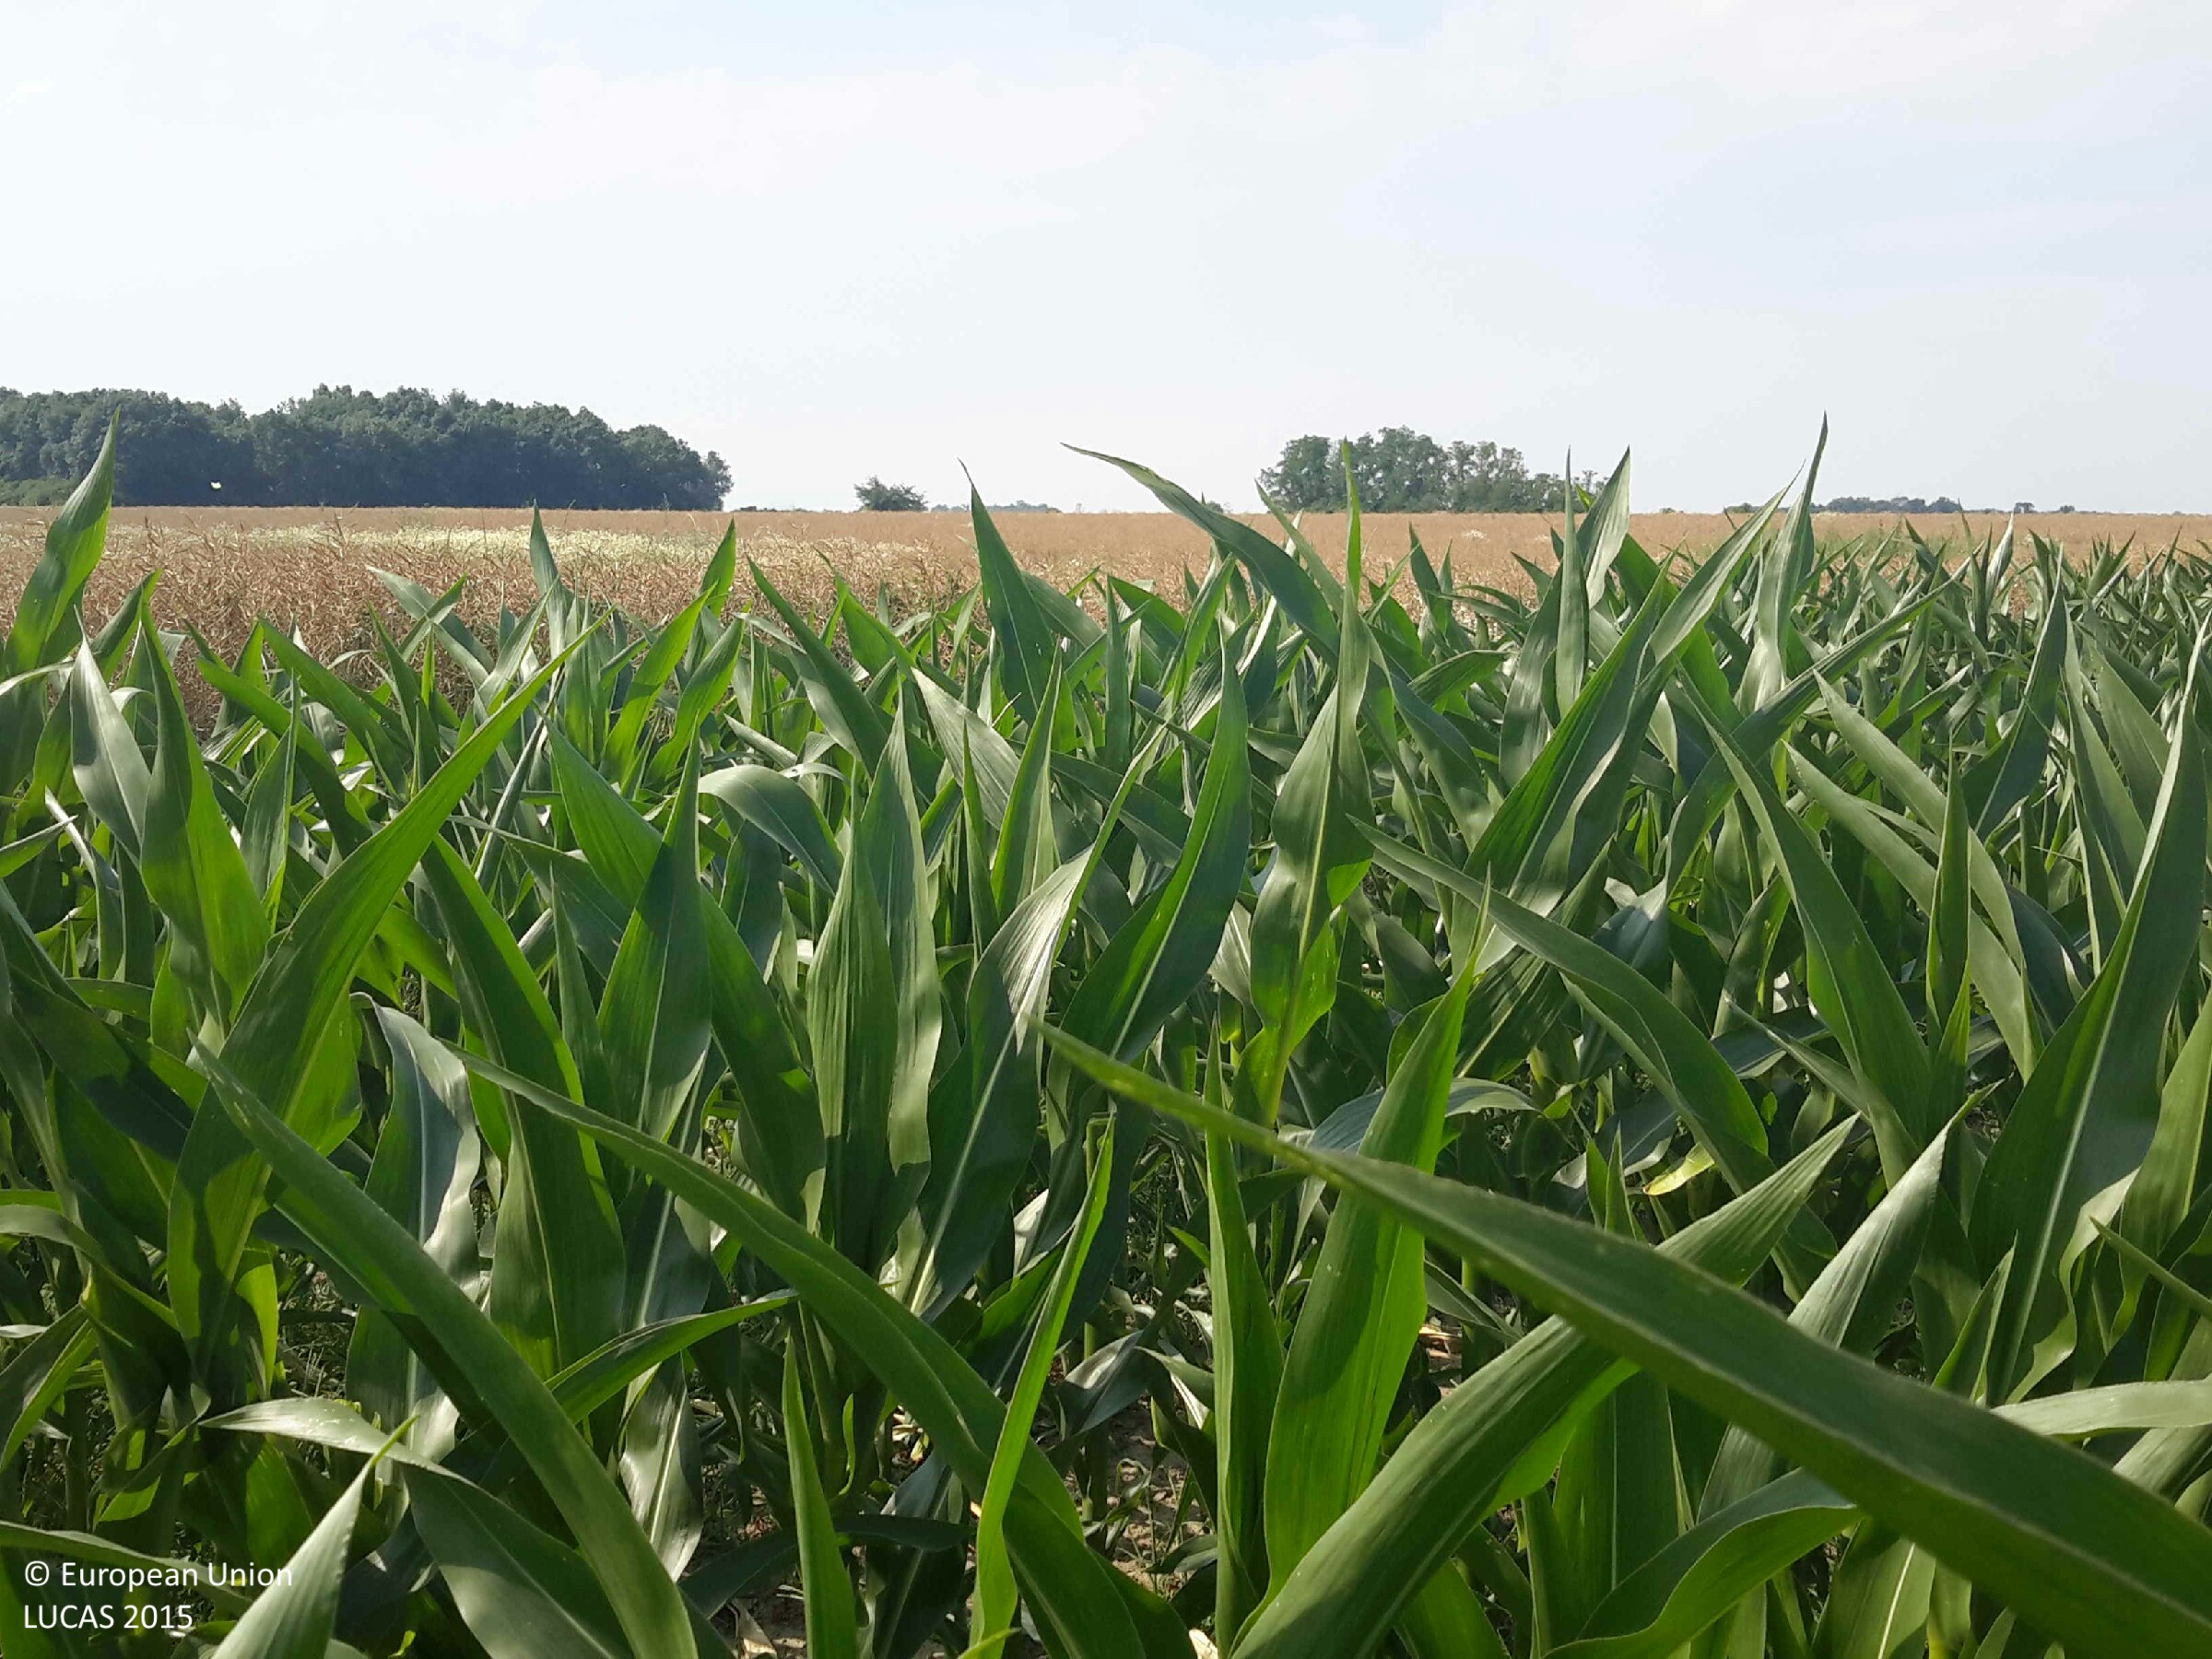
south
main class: Cropland
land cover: Maize
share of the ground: > 75 %
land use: Agriculture (excluding fallow land and kitchen gardens)
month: July
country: HU
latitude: 47.3955
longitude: 17.4135
